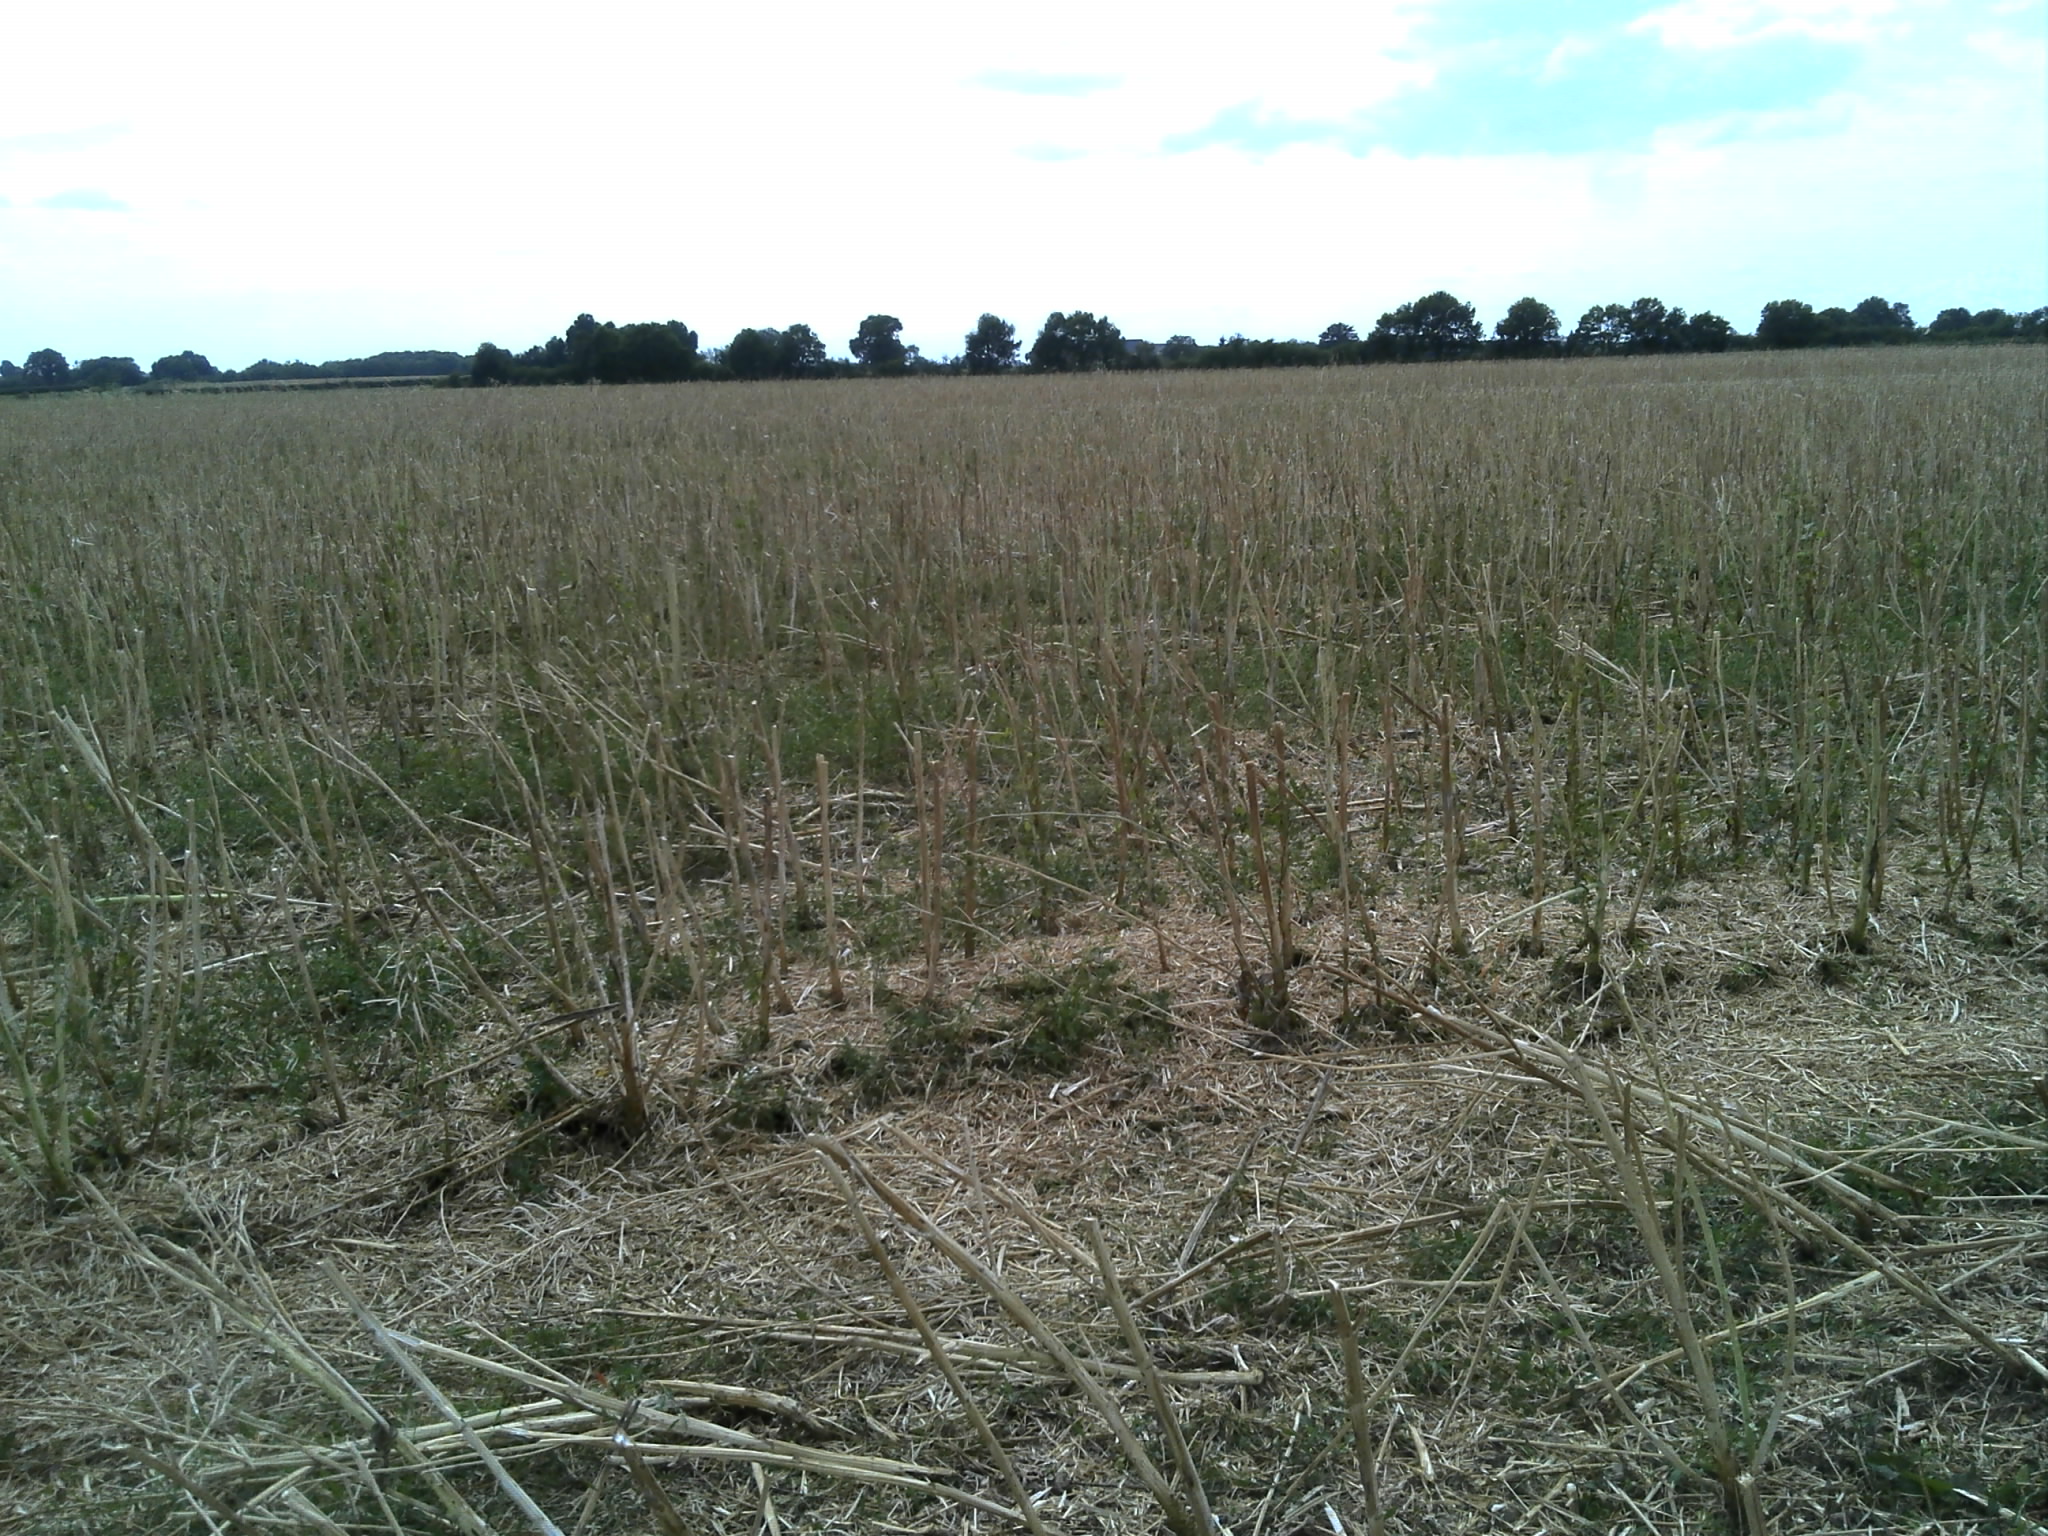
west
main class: Cropland
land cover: Rape and turnip rape
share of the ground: < 10 %
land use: Agriculture (excluding fallow land and kitchen gardens)
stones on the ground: < 10 %
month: July
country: FR
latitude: 46.6984
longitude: 1.4751
